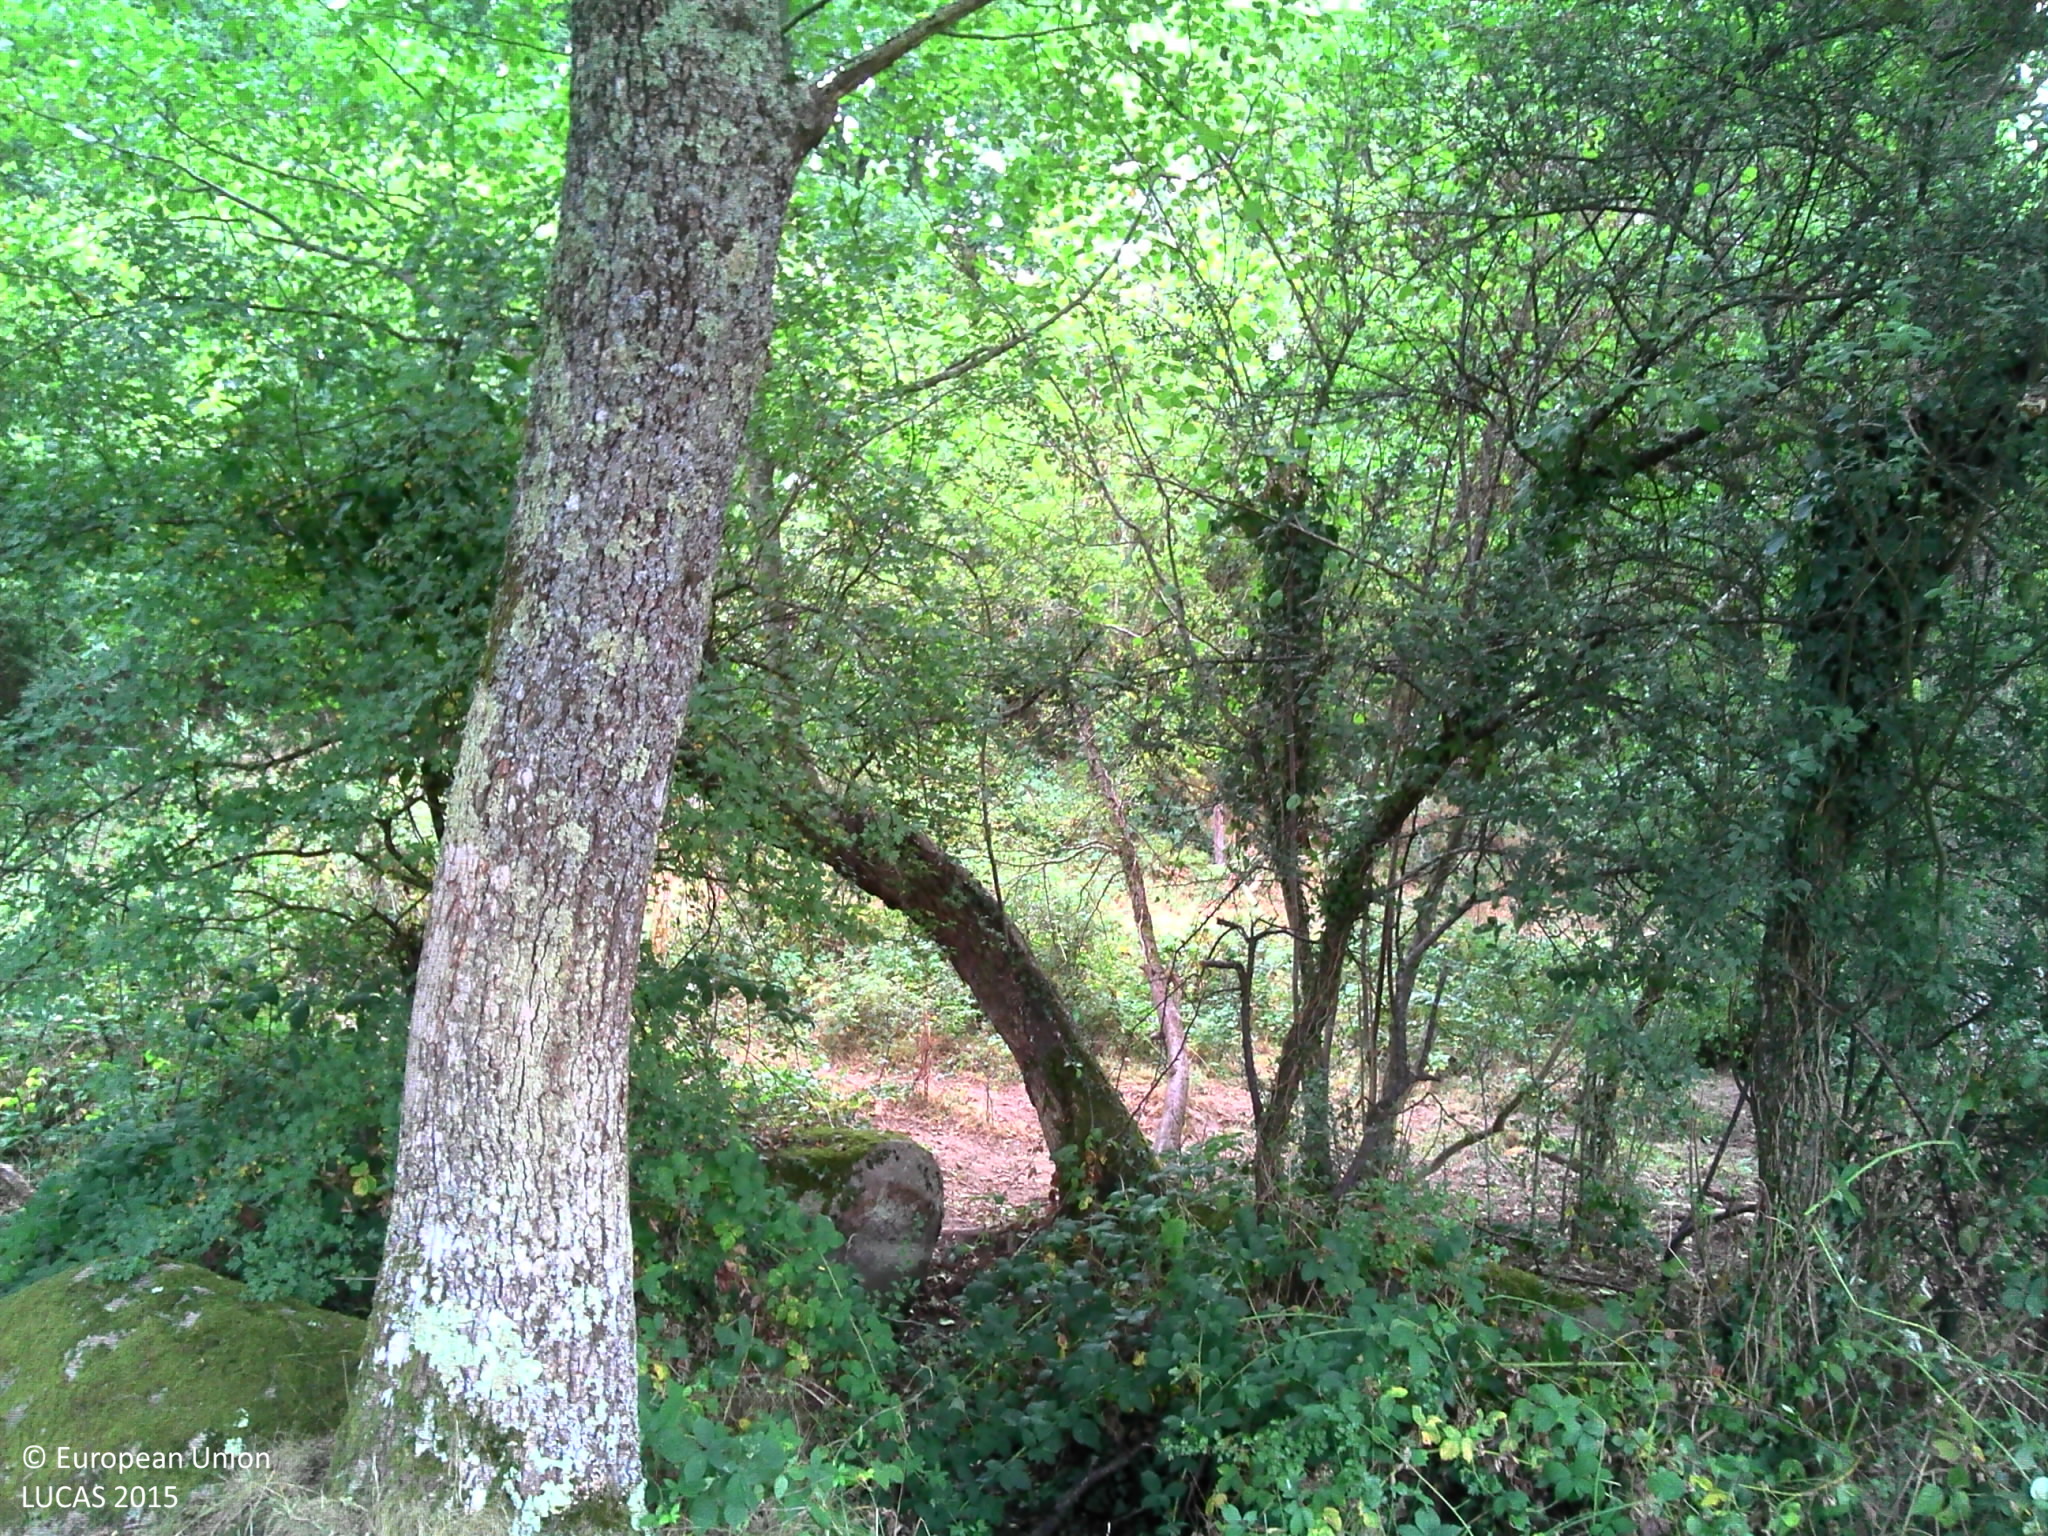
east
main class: Grassland
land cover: Grassland without tree/shrub cover
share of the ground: > 75 %
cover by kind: herbaceous plants 100 %
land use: Agriculture (excluding fallow land and kitchen gardens)
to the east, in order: Grassland without tree/shrub cover; Broadleaved woodland; Rocks and stones; Grassland with sparse tree/shrub cover; Fences; Broadleaved woodland; Spontaneously vegetated surfaces; Pine dominated coniferous woodland
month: July
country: FR
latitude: 46.5806
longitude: 2.8320
